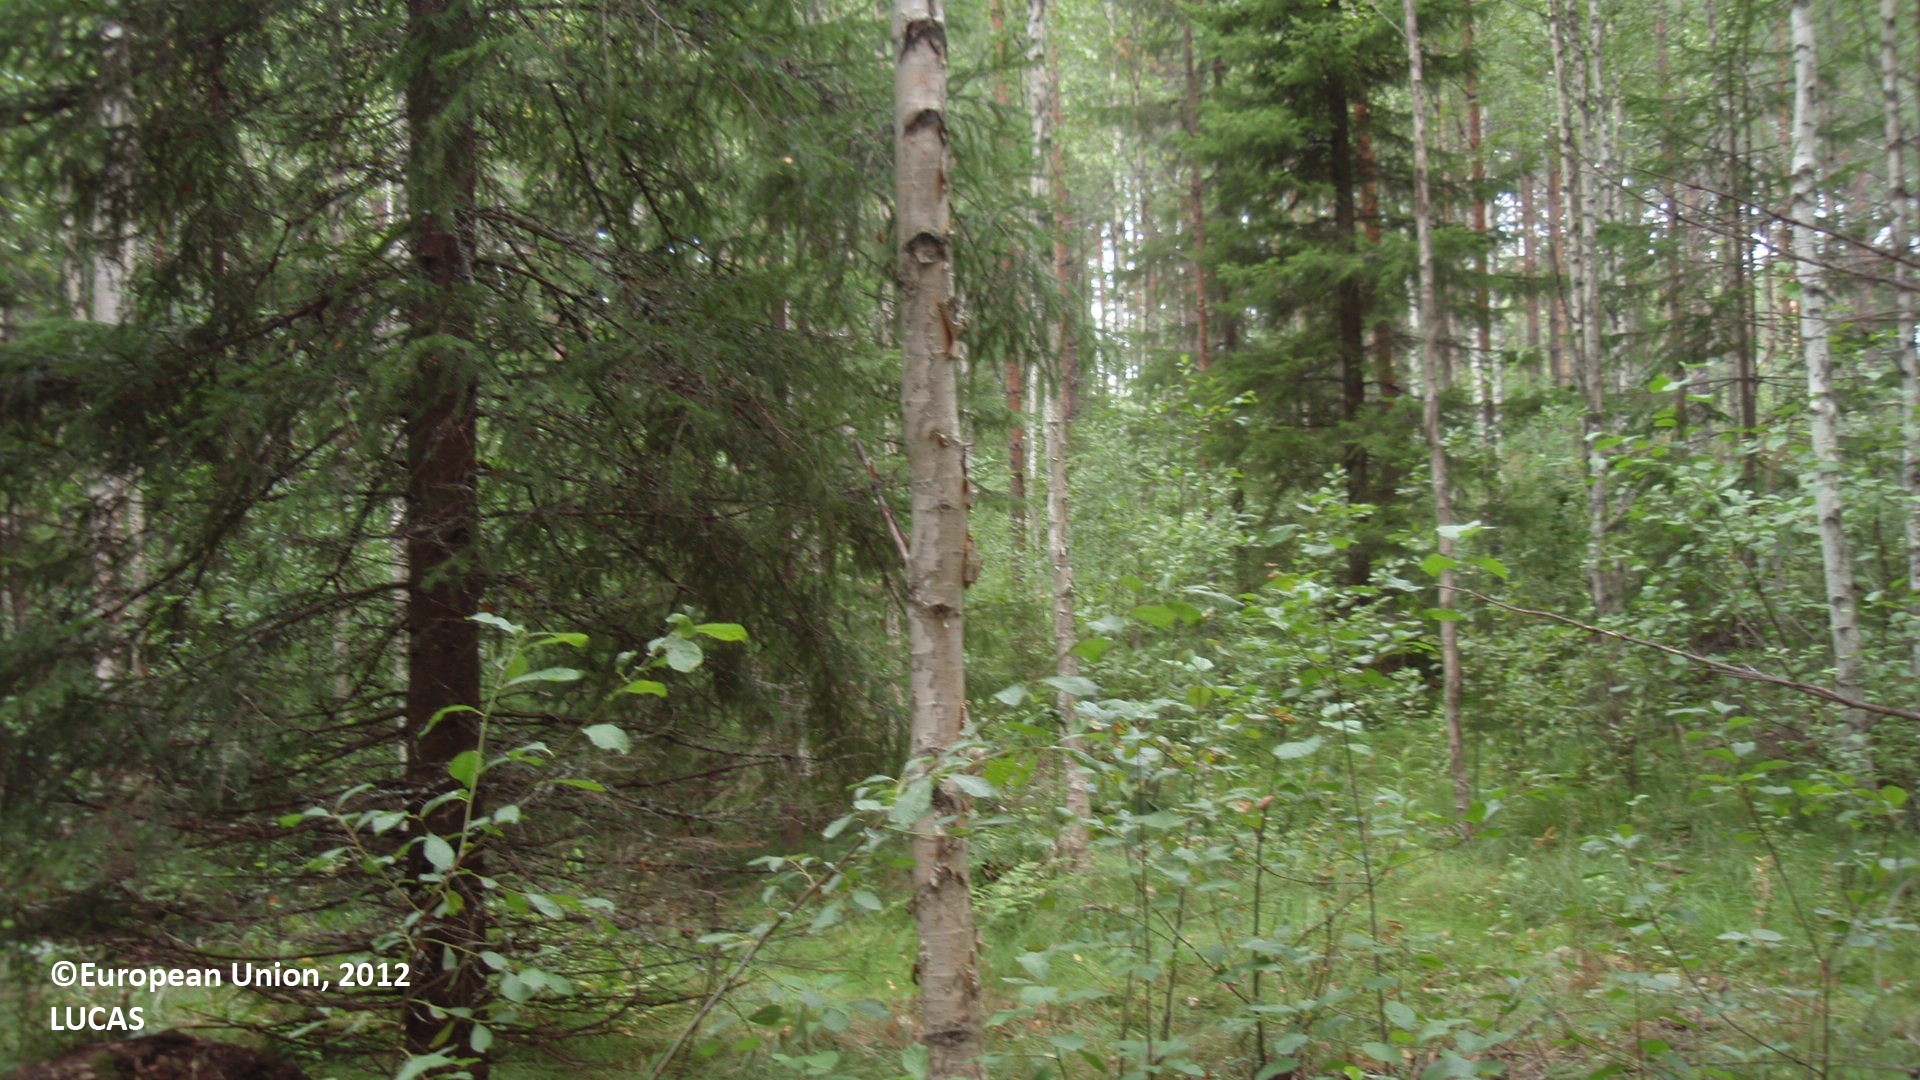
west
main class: Woodland
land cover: Other coniferous woodland
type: boreal forest
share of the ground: > 75 %
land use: Forestry
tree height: > 5 m
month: August
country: FI
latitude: 61.1200
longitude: 27.4217
